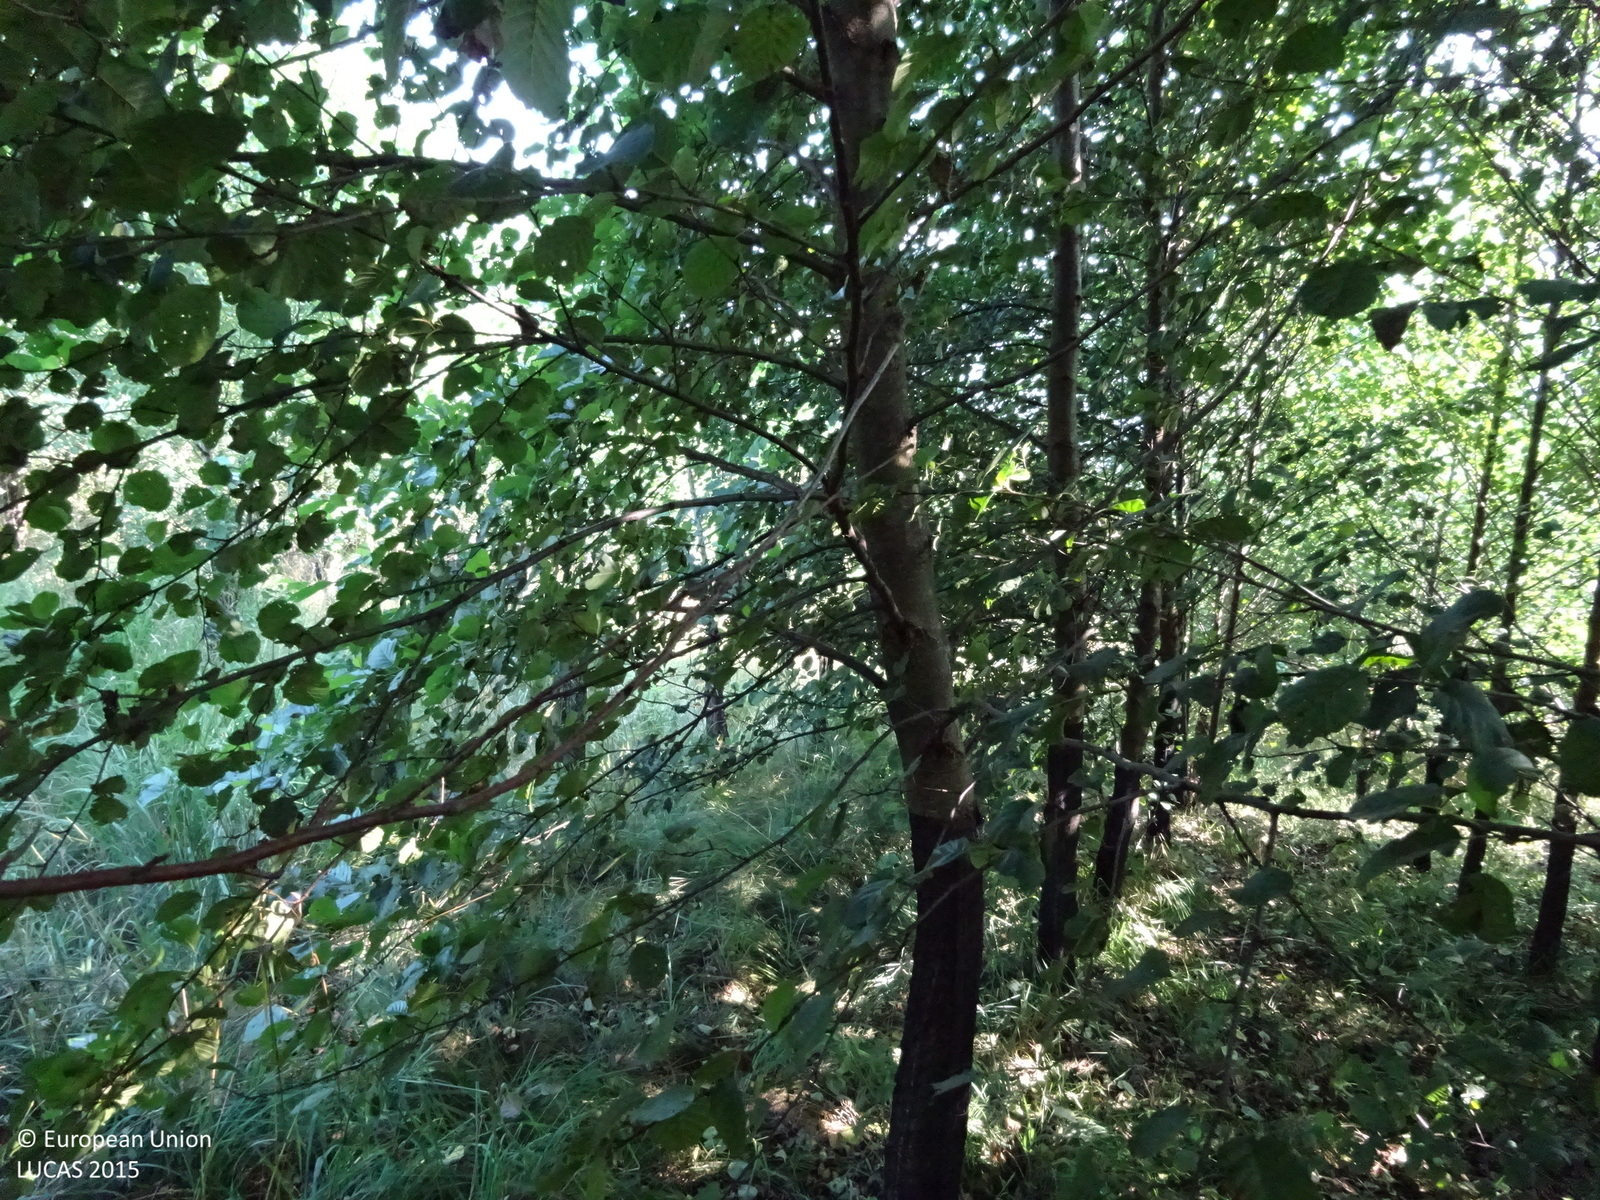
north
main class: Woodland
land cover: Broadleaved woodland
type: hemiboreal forest and nemoral coniferous forest and mixed broadleaved-coniferous forest
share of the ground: > 75 %
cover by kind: broadleaved forest trees 100 %
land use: Forestry
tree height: > 5 m
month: July
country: AT
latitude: 46.8790
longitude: 15.4712
